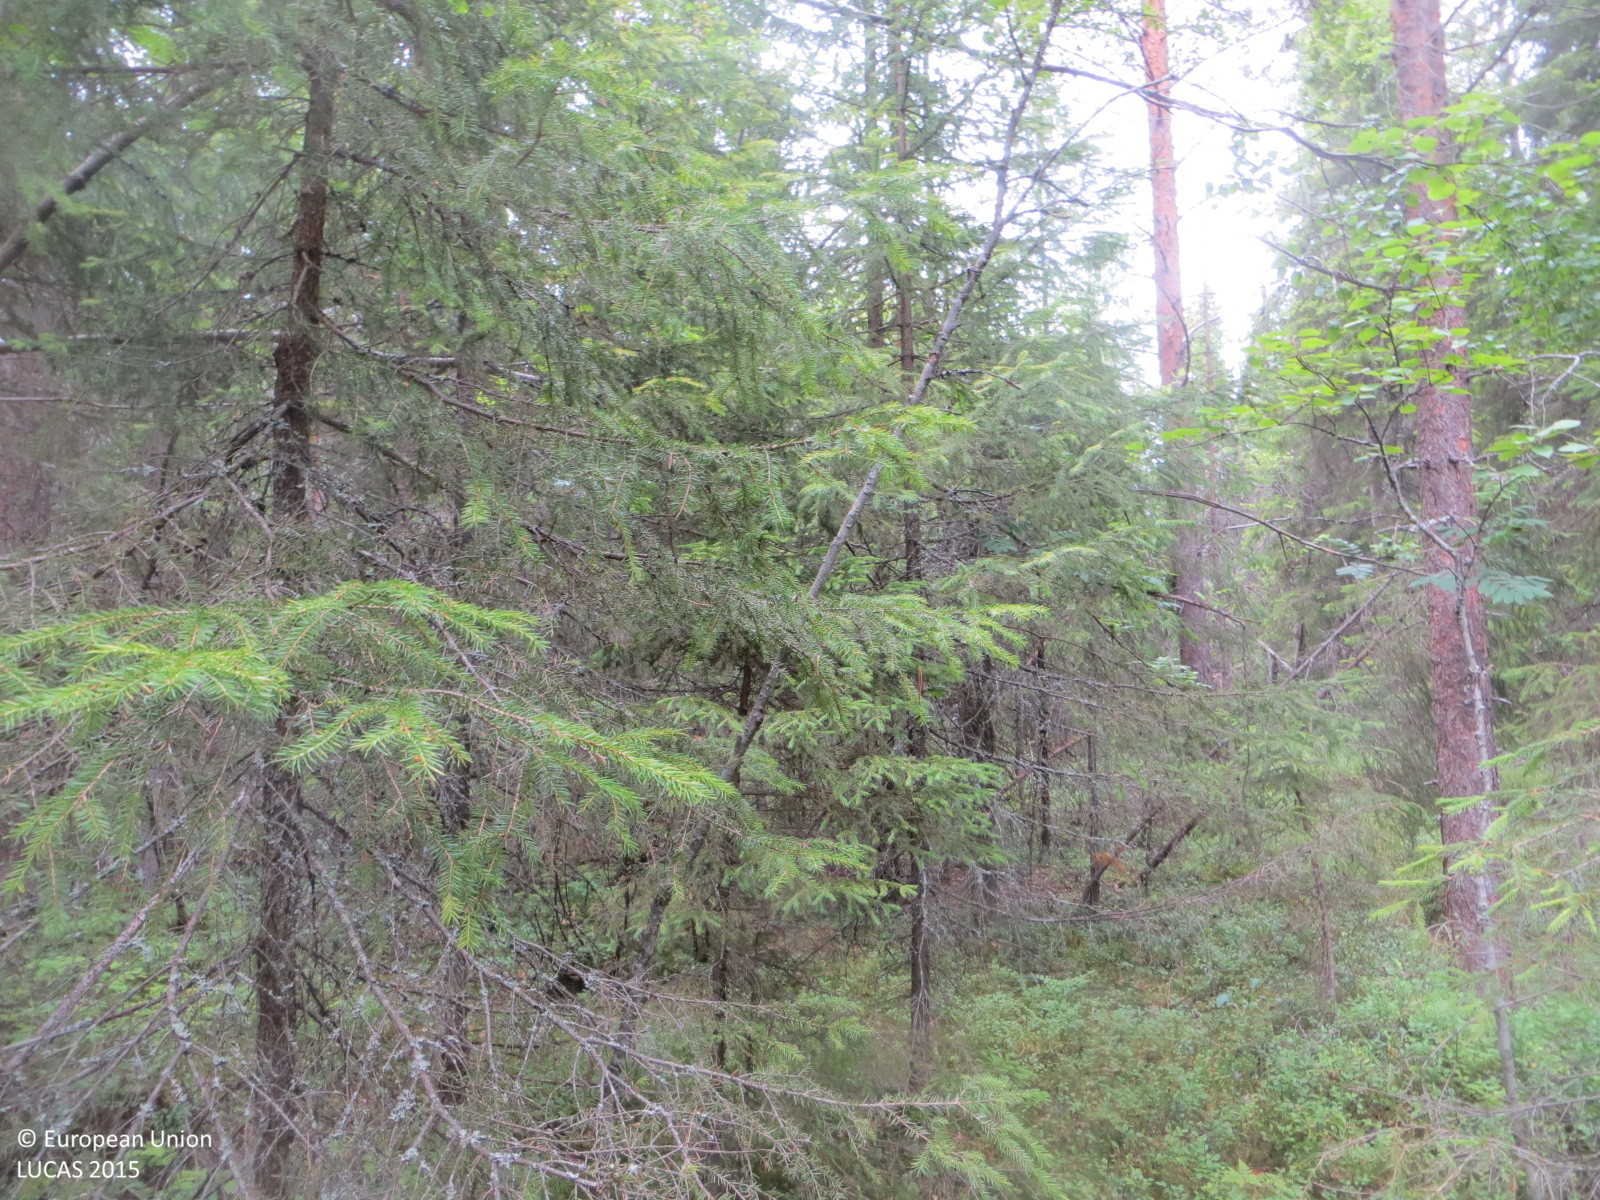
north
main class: Woodland
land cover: Spruce dominated mixed woodland
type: boreal forest
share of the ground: 50 - 75 %
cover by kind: coniferous forest trees 35 %, shrubs 35 %, broadleaved forest trees 30 %
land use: Forestry
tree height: > 5 m
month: July
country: FI
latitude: 65.8110
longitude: 24.5109
